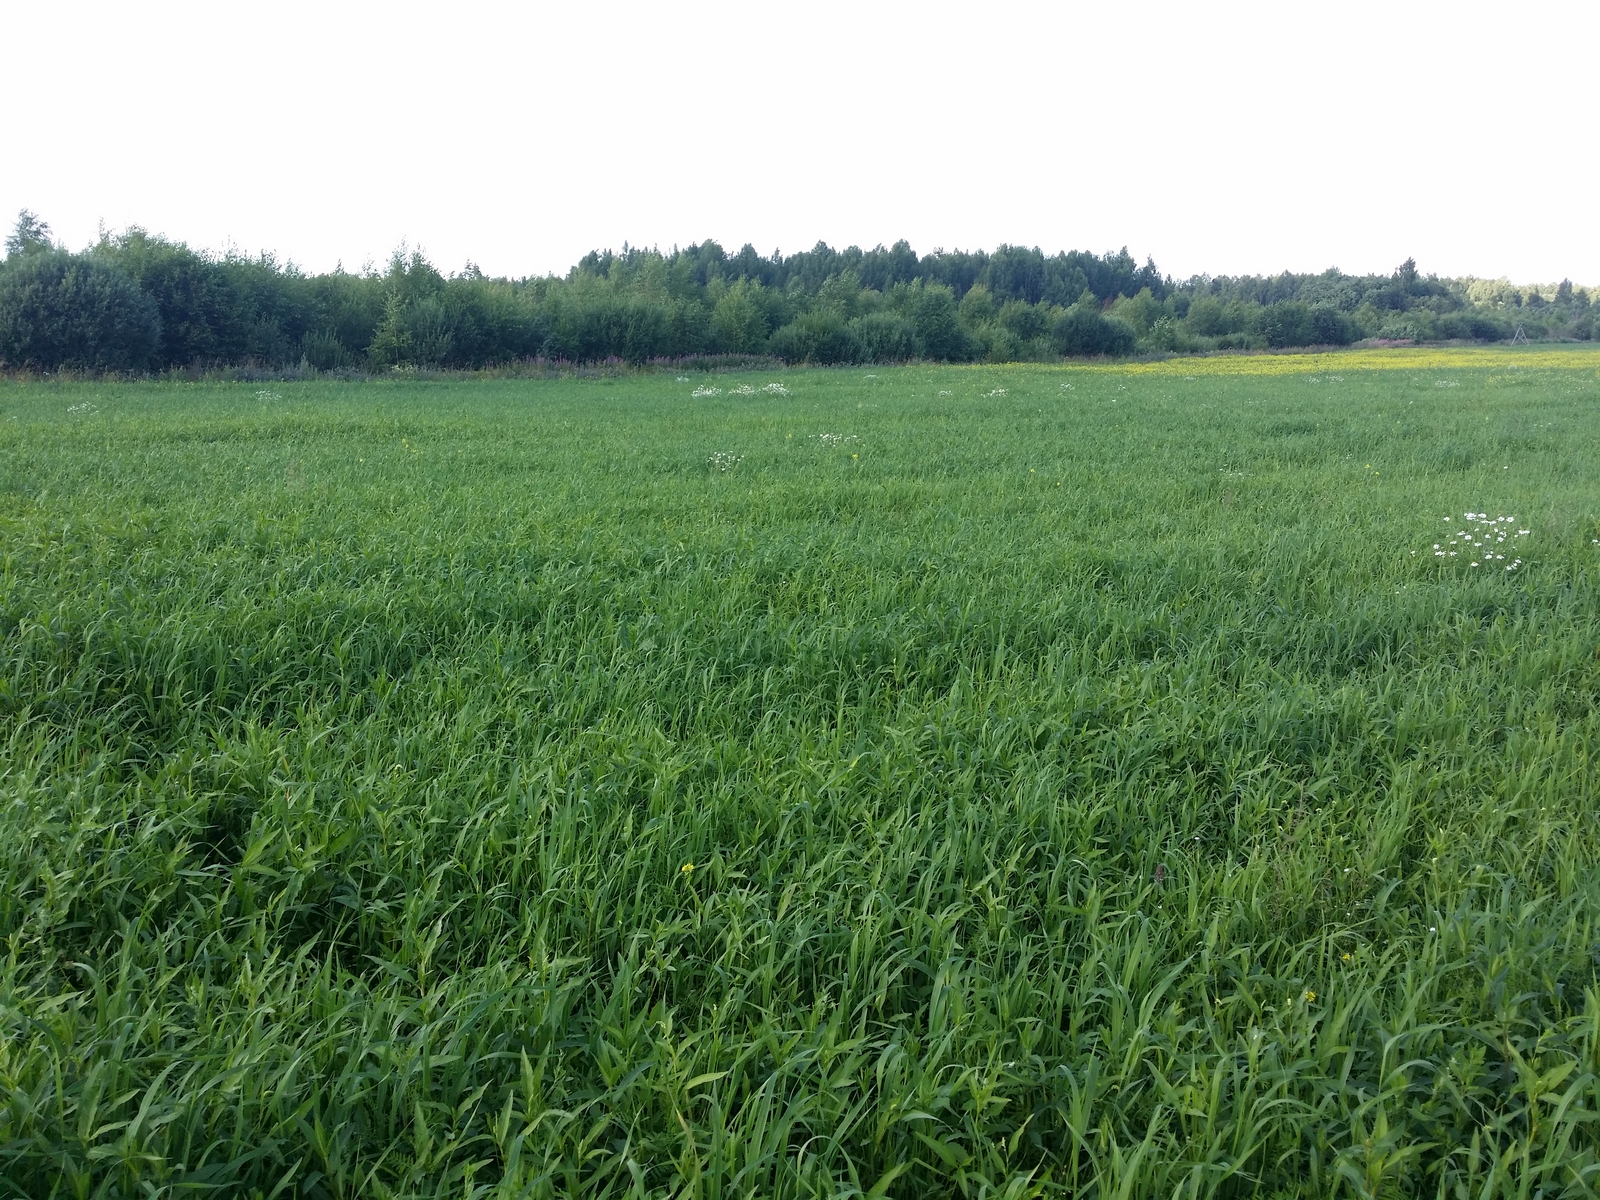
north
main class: Grassland
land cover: Grassland without tree/shrub cover
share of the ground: > 75 %
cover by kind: herbaceous plants 100 %
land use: Agriculture (excluding fallow land and kitchen gardens)
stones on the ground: < 10 %
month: July
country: LV
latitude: 57.2209
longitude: 27.2414
